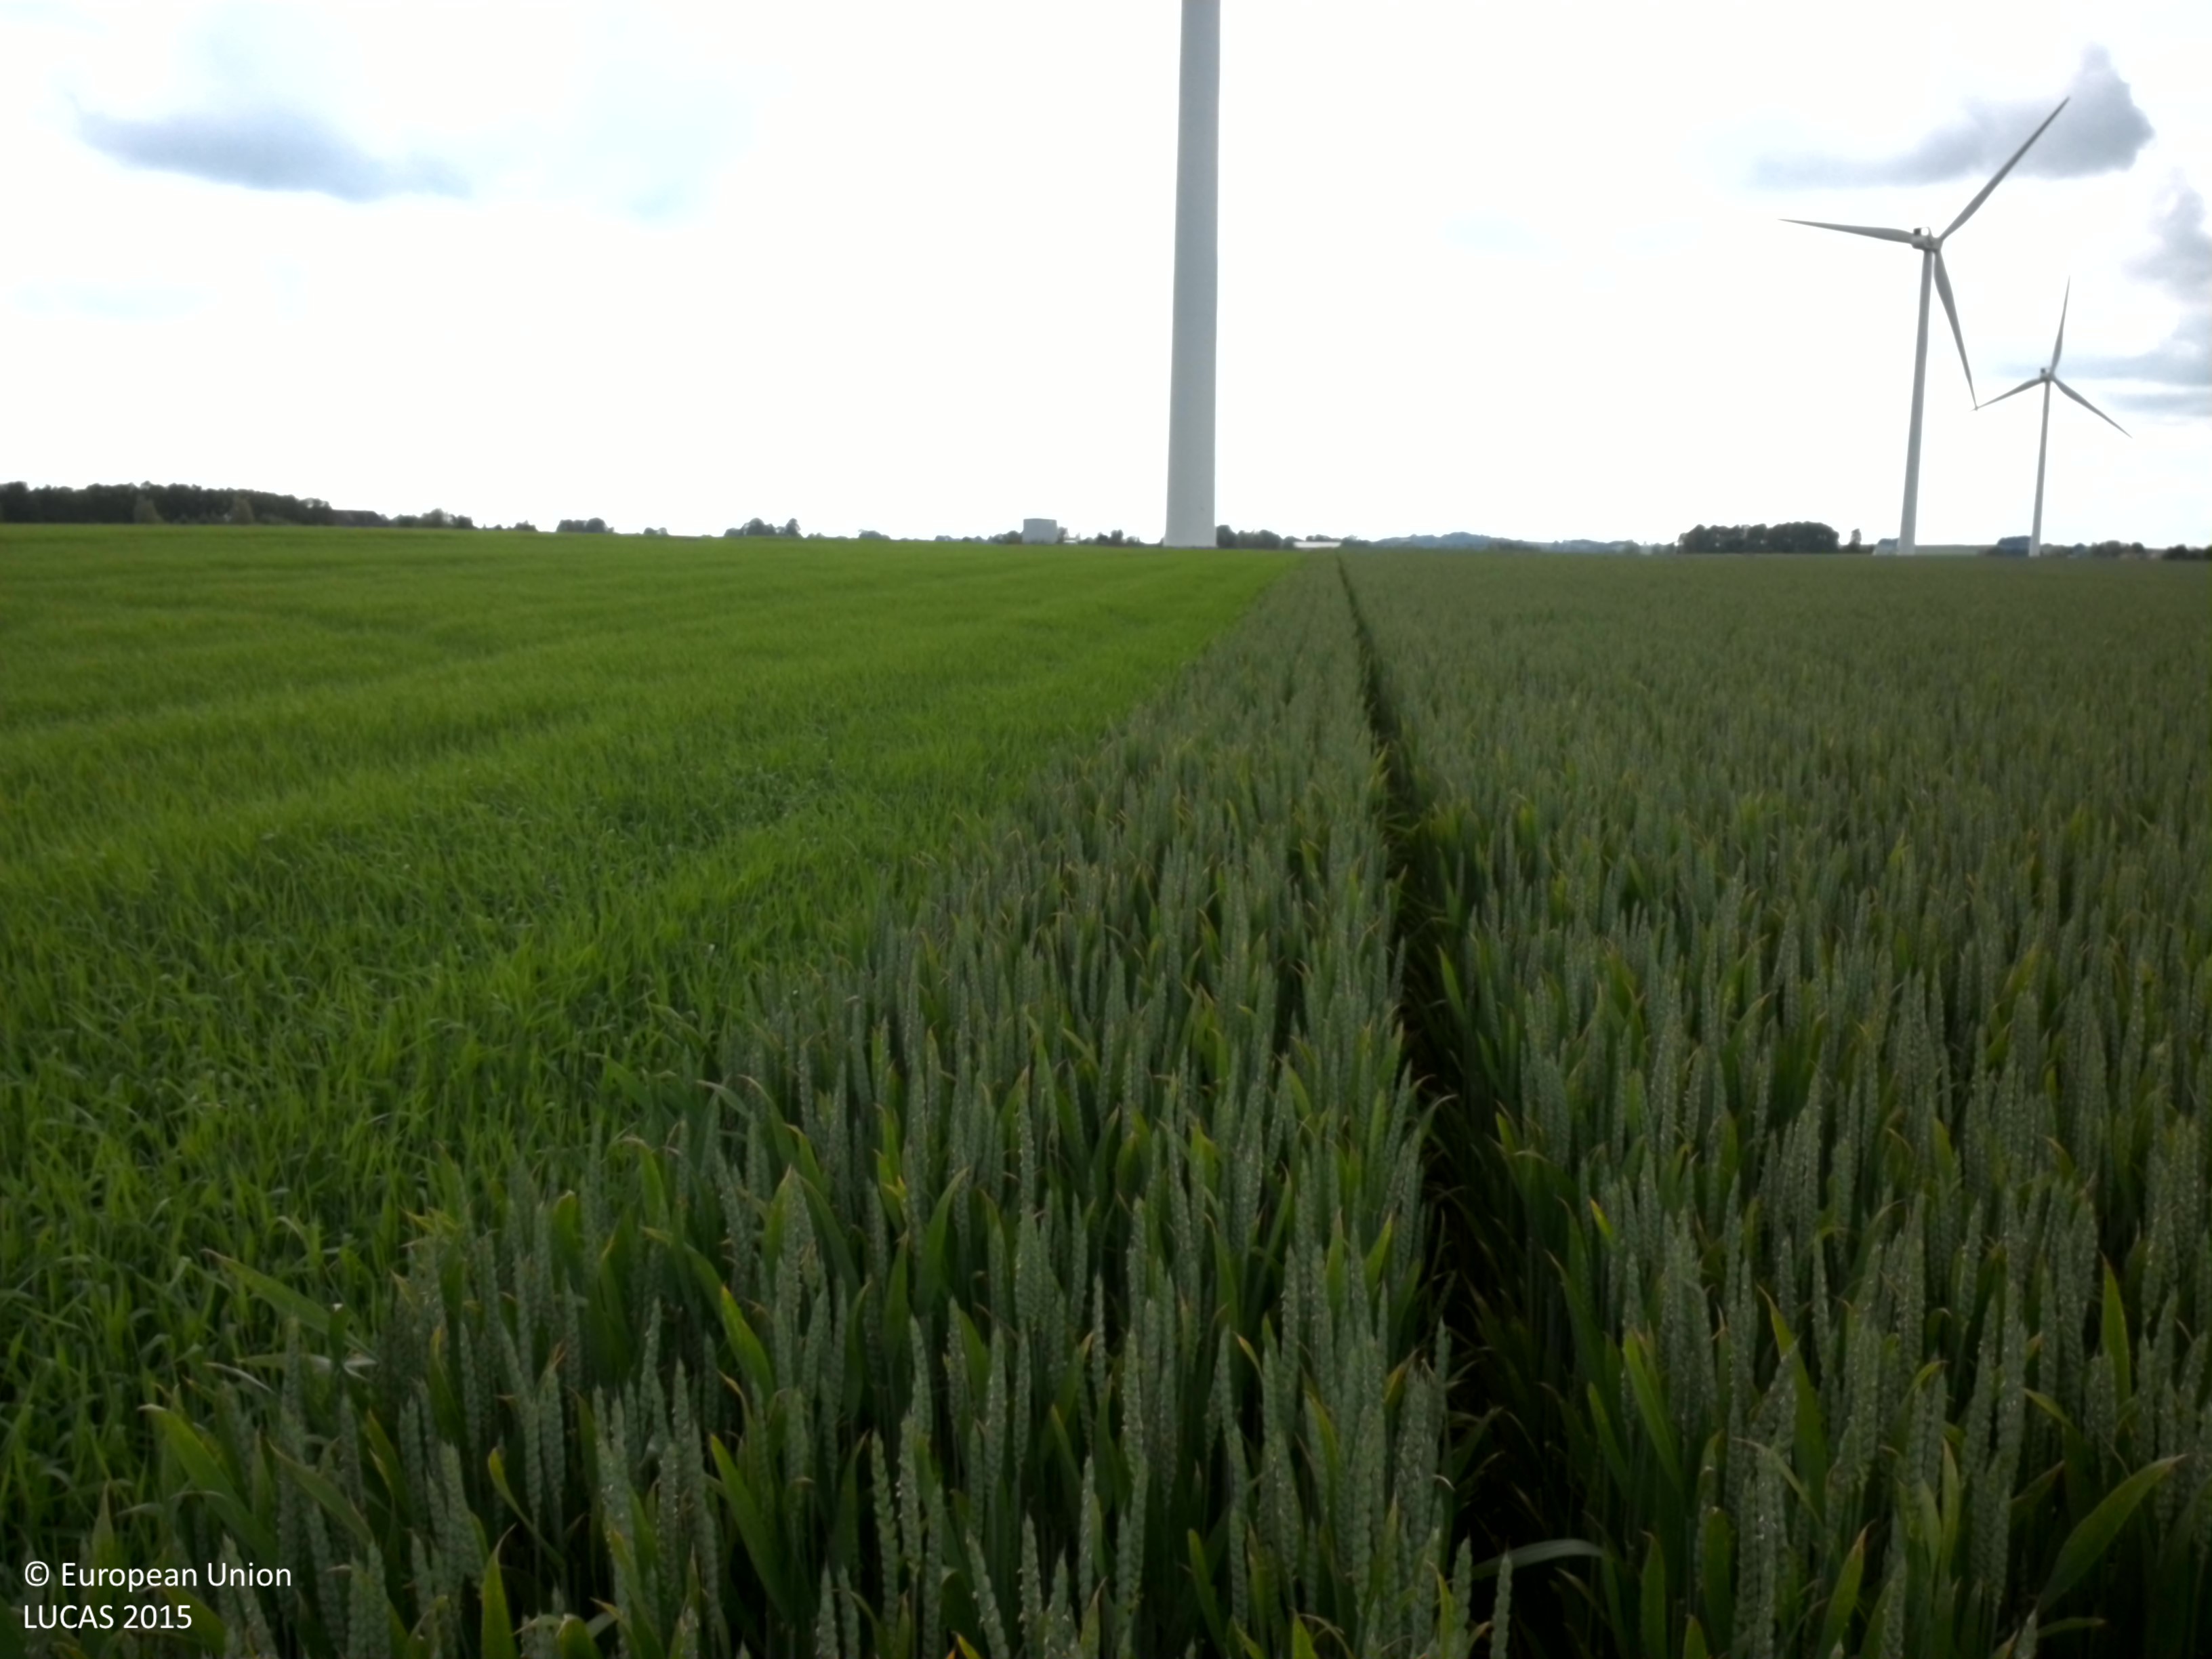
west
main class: Cropland
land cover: Common wheat
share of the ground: > 75 %
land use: Agriculture (excluding fallow land and kitchen gardens)
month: June
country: SE
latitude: 55.8255
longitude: 13.1425
